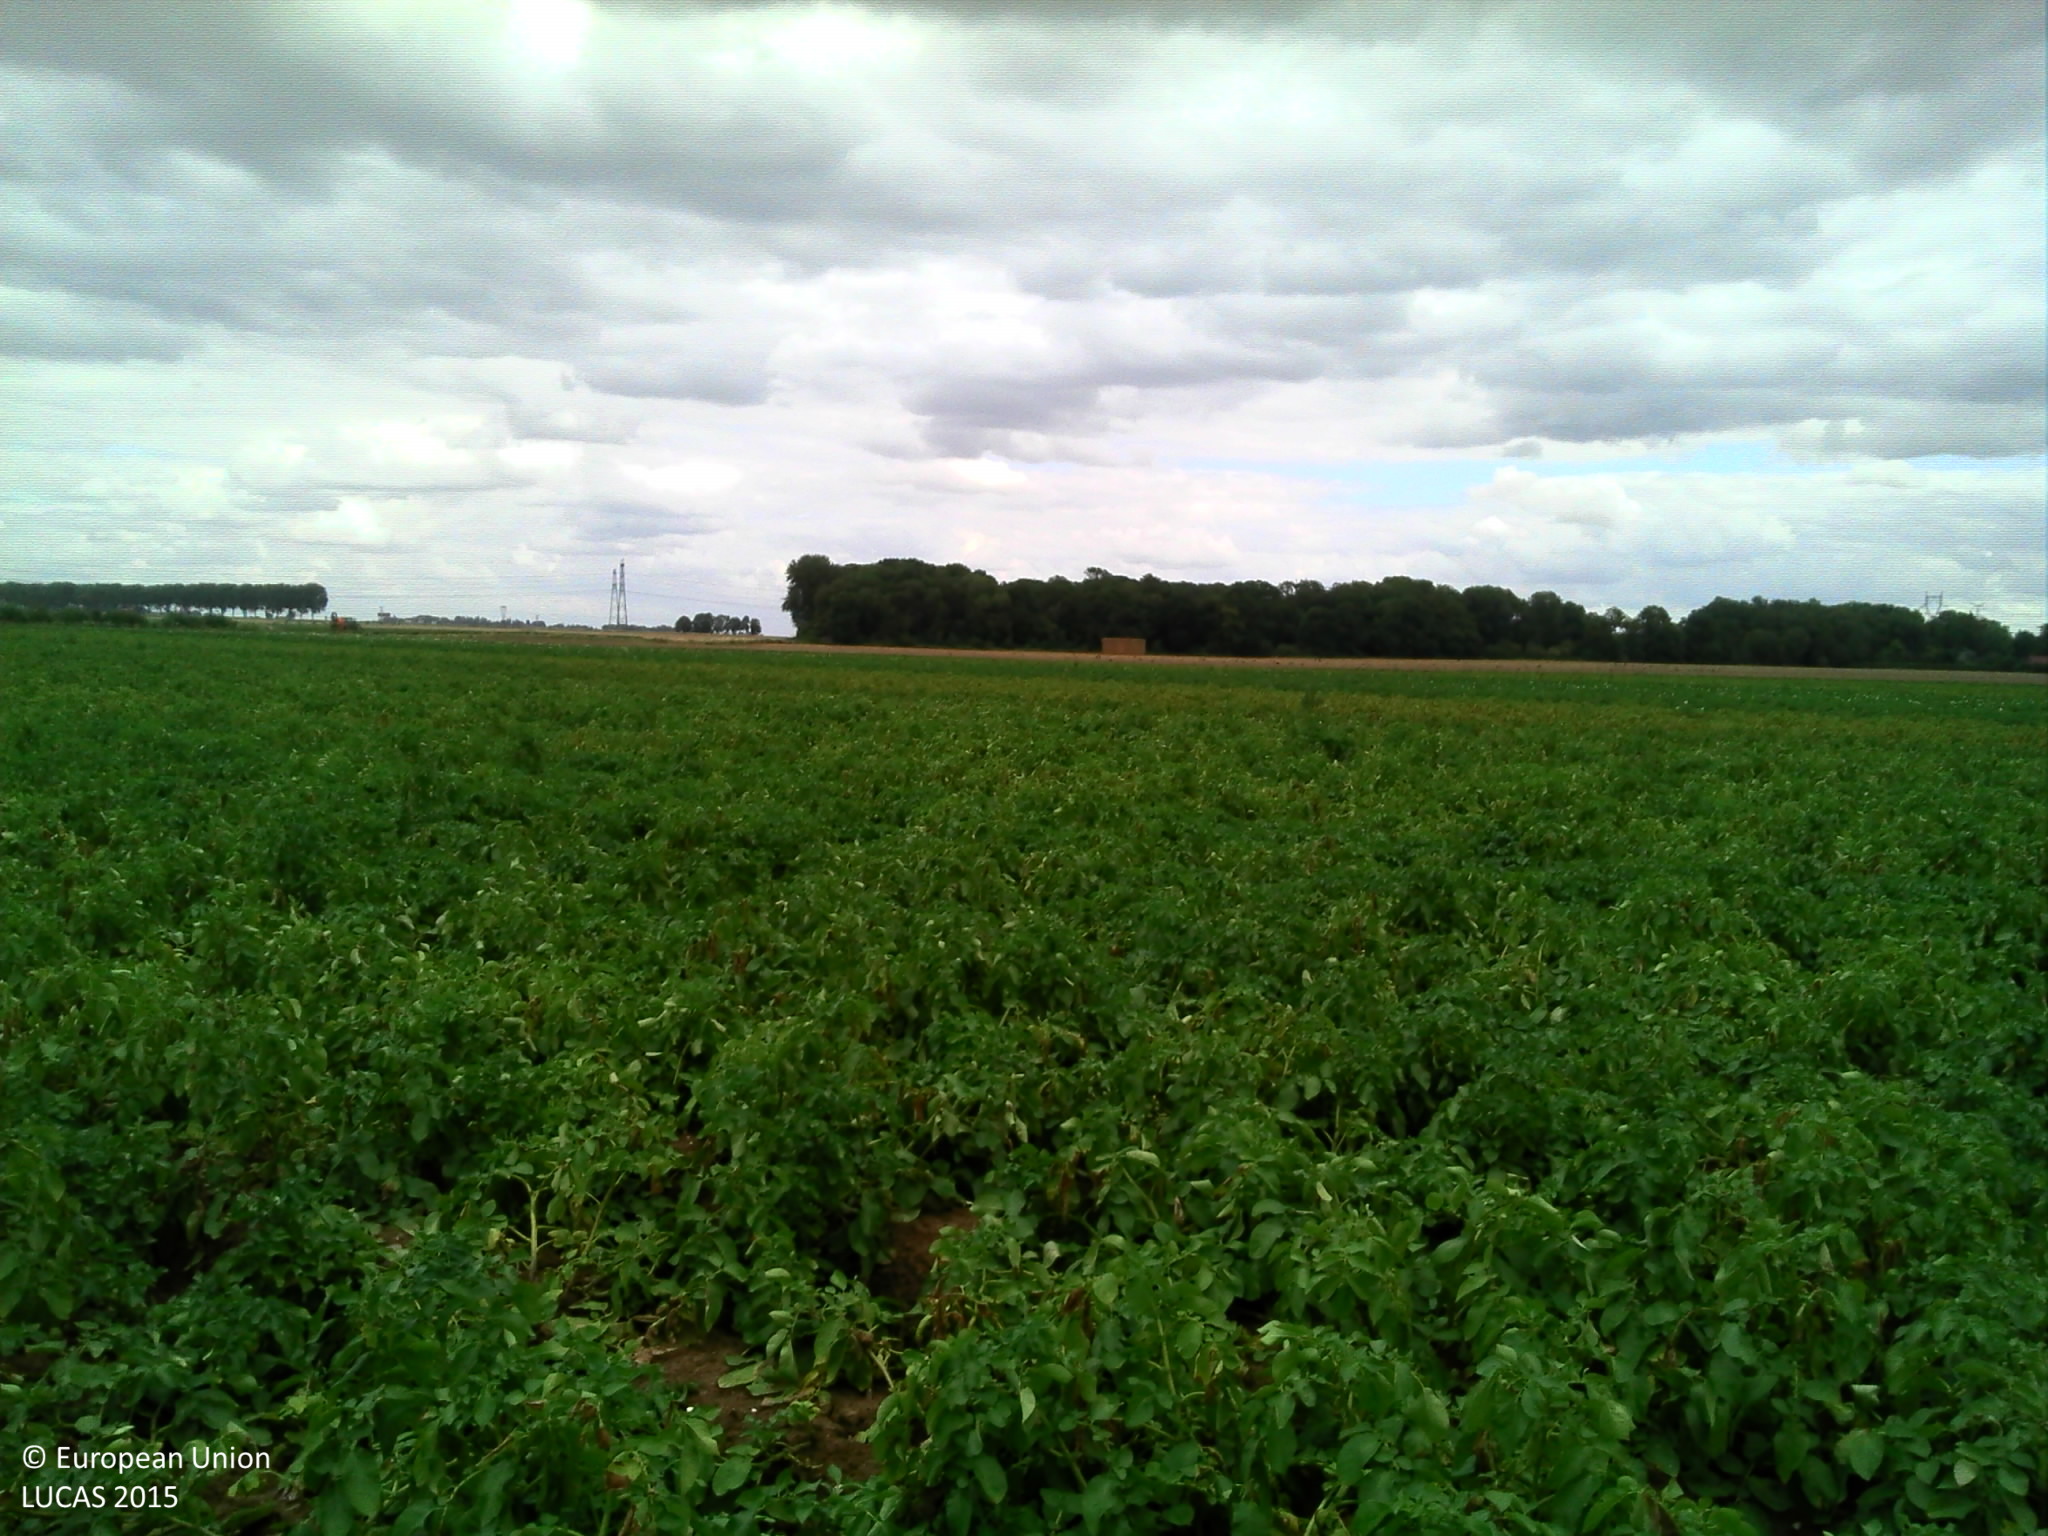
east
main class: Cropland
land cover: Potatoes
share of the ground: > 75 %
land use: Agriculture (excluding fallow land and kitchen gardens)
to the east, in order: Potatoes; Other fibre and oleaginous crops
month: August
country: FR
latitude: 49.8141
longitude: 2.8323
